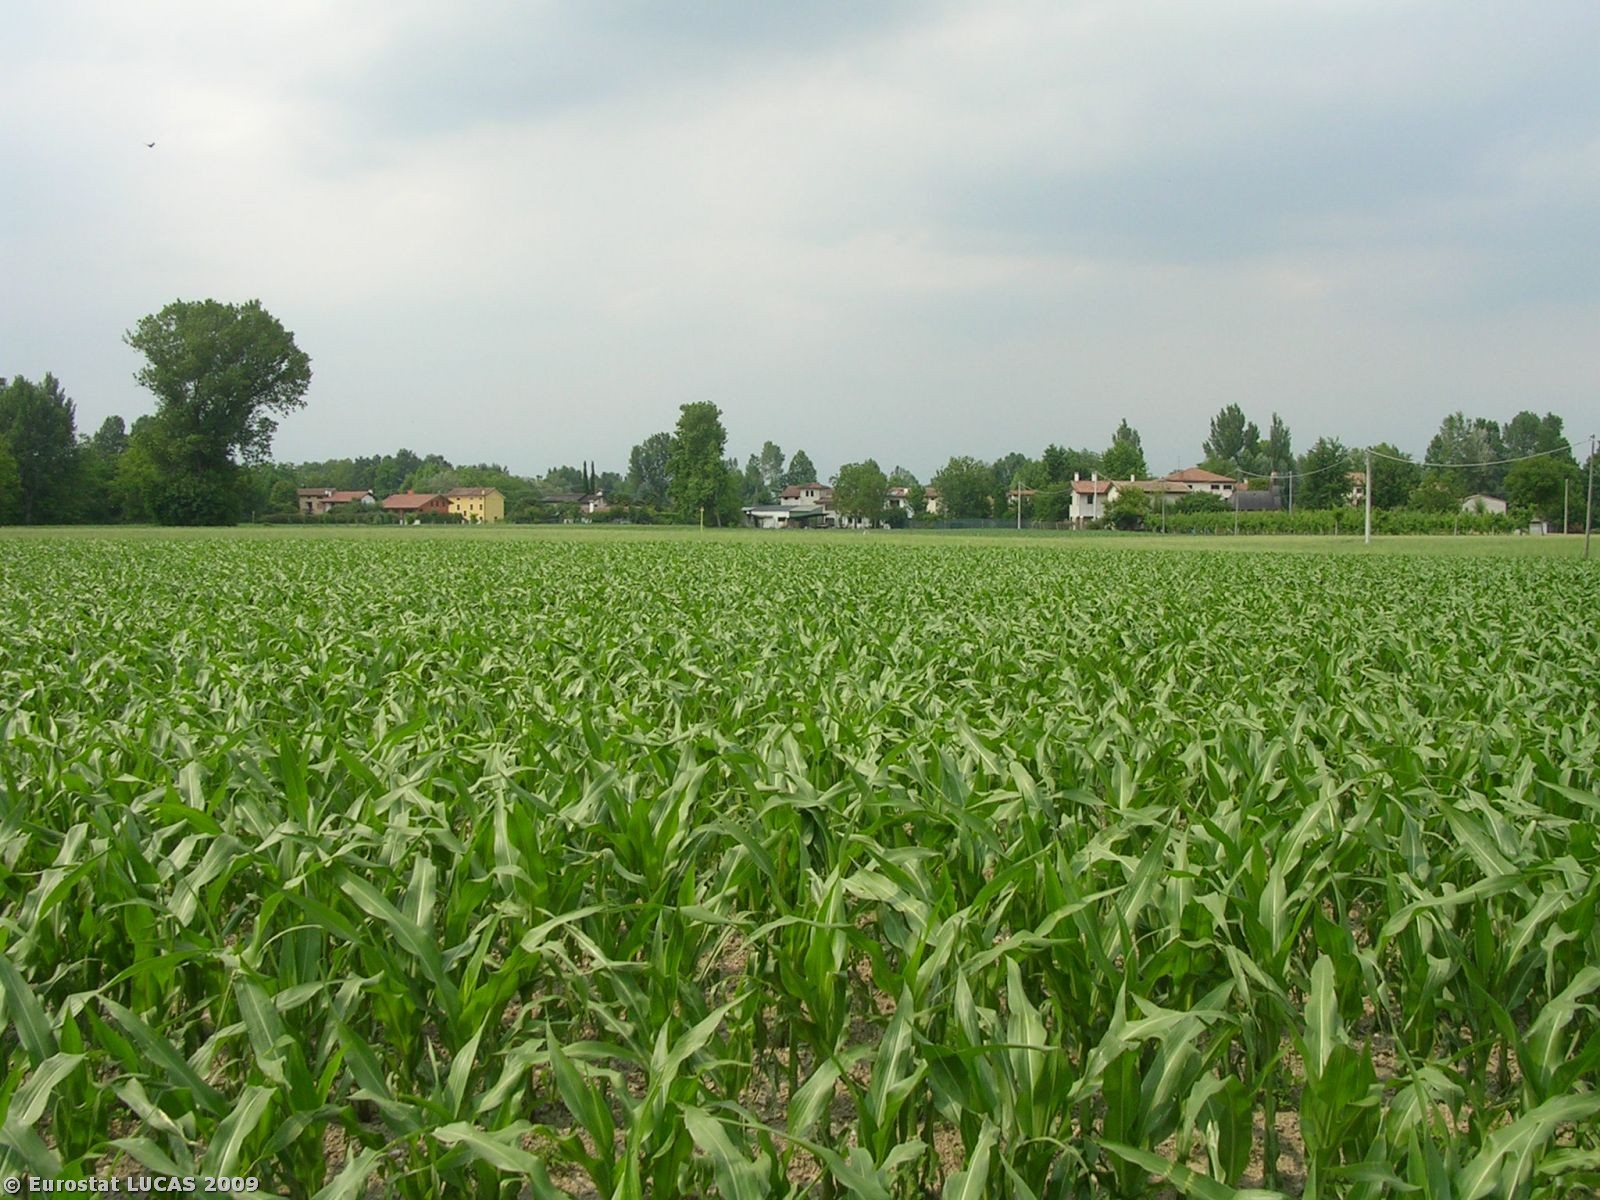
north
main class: Cropland
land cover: Maize
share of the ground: > 75 %
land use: Agriculture (excluding fallow land and kitchen gardens)
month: June
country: IT
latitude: 45.6160
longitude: 11.7541
